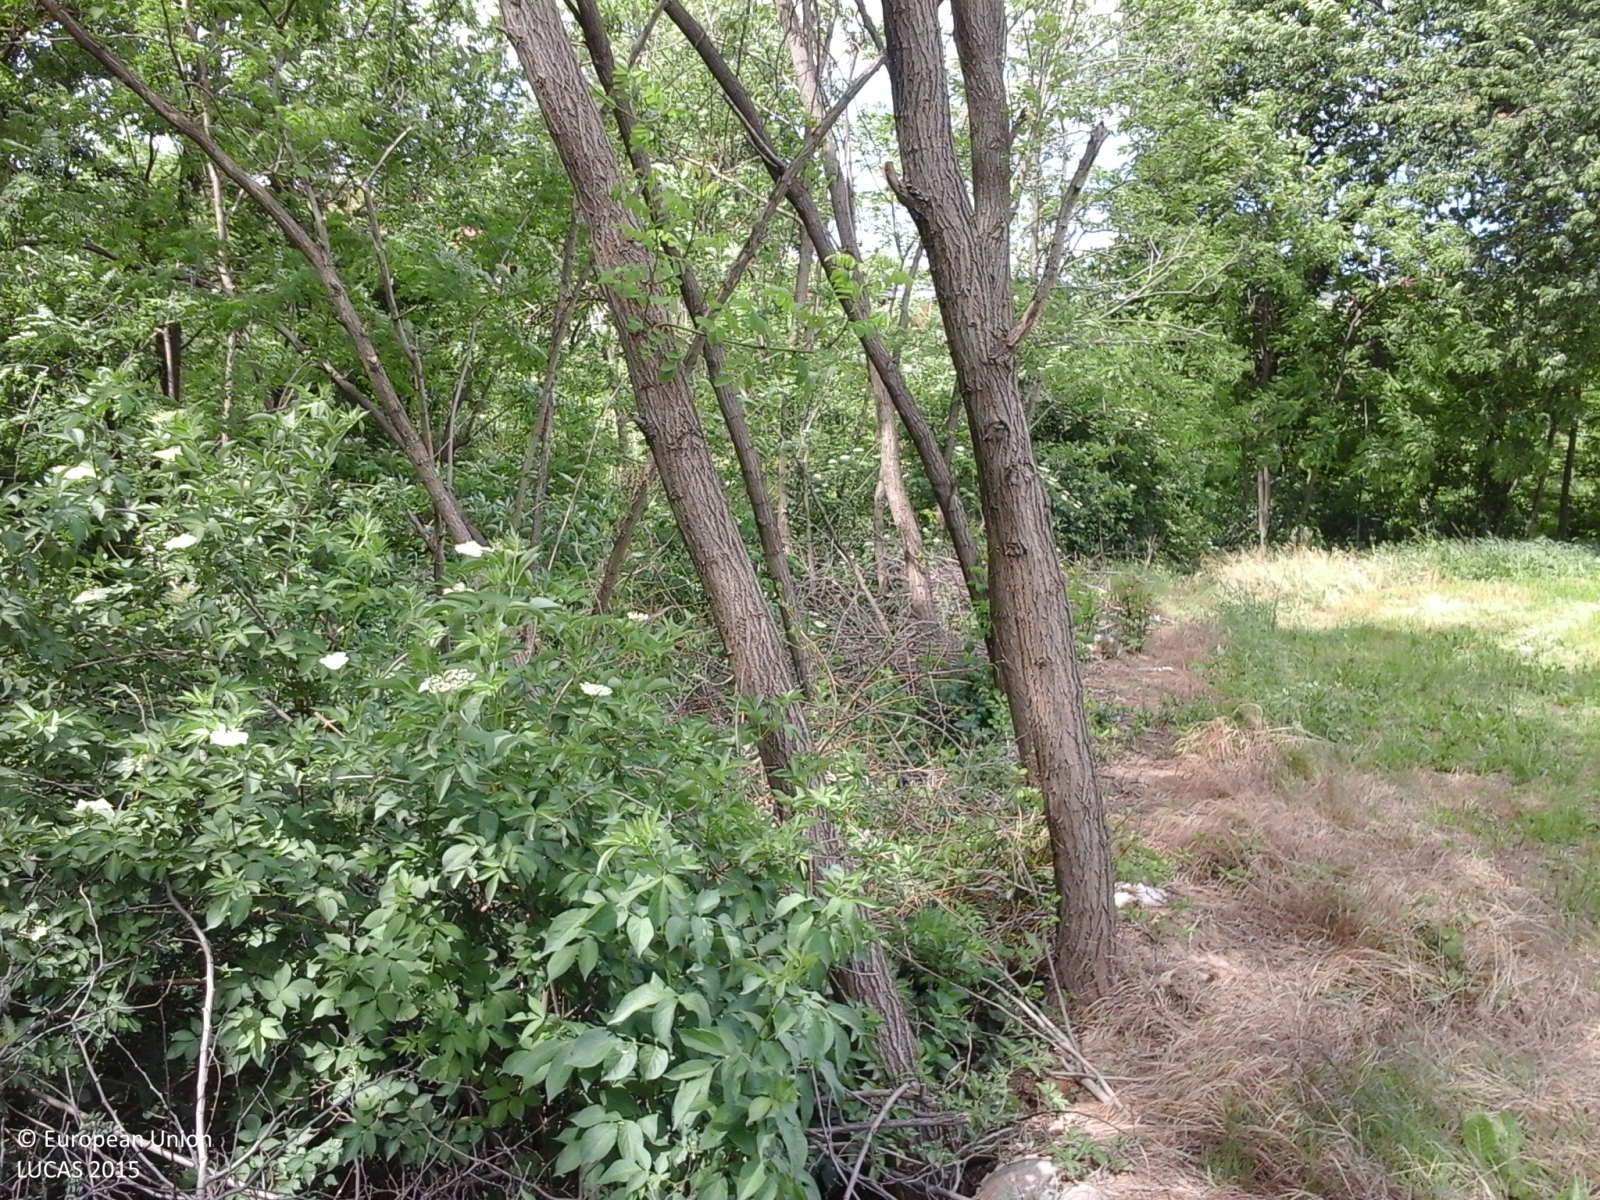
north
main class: Woodland
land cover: Broadleaved woodland
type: thermophilous deciduous forest
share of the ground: > 75 %
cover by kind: broadleaved forest trees 100 %
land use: Semi-natural and natural areas not in use
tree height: > 5 m
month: May
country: IT
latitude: 44.4722
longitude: 7.8298
